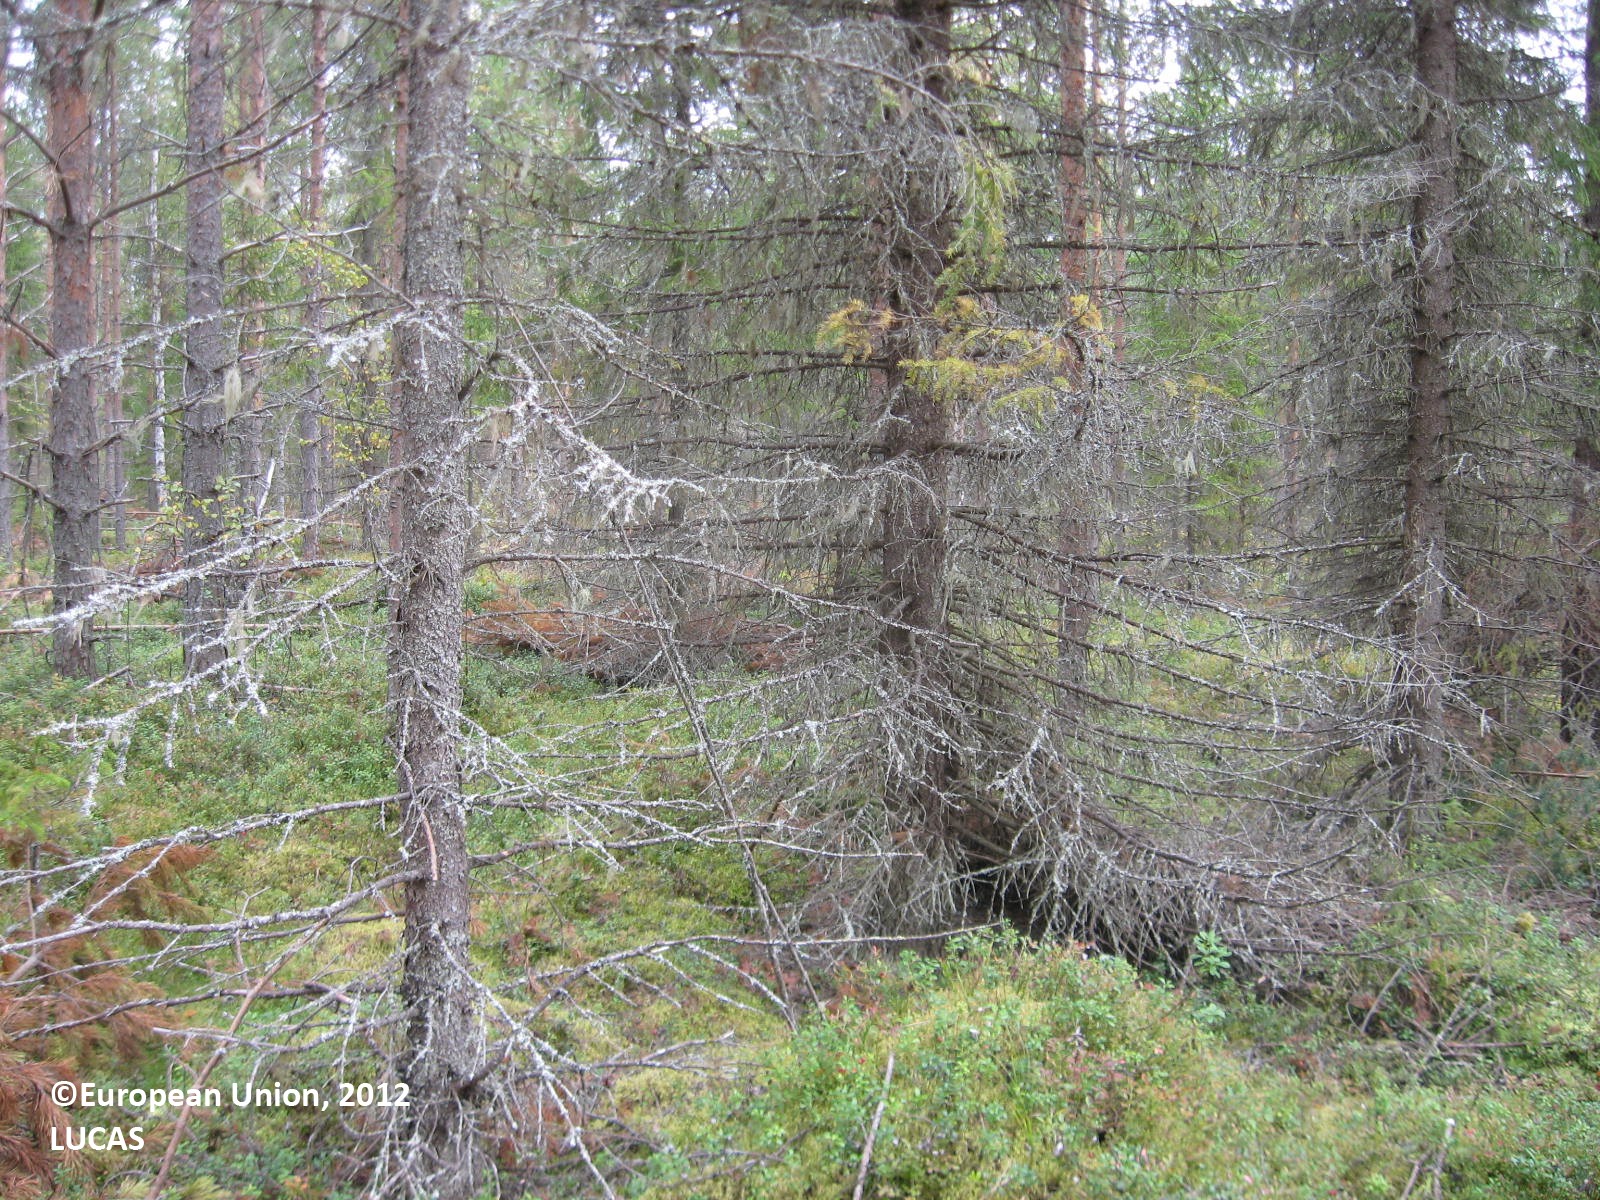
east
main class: Woodland
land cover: Pine dominated coniferous woodland
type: boreal forest
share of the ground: > 75 %
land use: Forestry
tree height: > 5 m
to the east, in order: Pine dominated coniferous woodland; Ditches and canals; Pine dominated coniferous woodland; Ditches and canals; Pine dominated coniferous woodland; Ditches and canals; Other mixed woodland; Ditches and canals; Pine dominated coniferous woodland
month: September
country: FI
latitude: 64.0809
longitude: 28.3226
